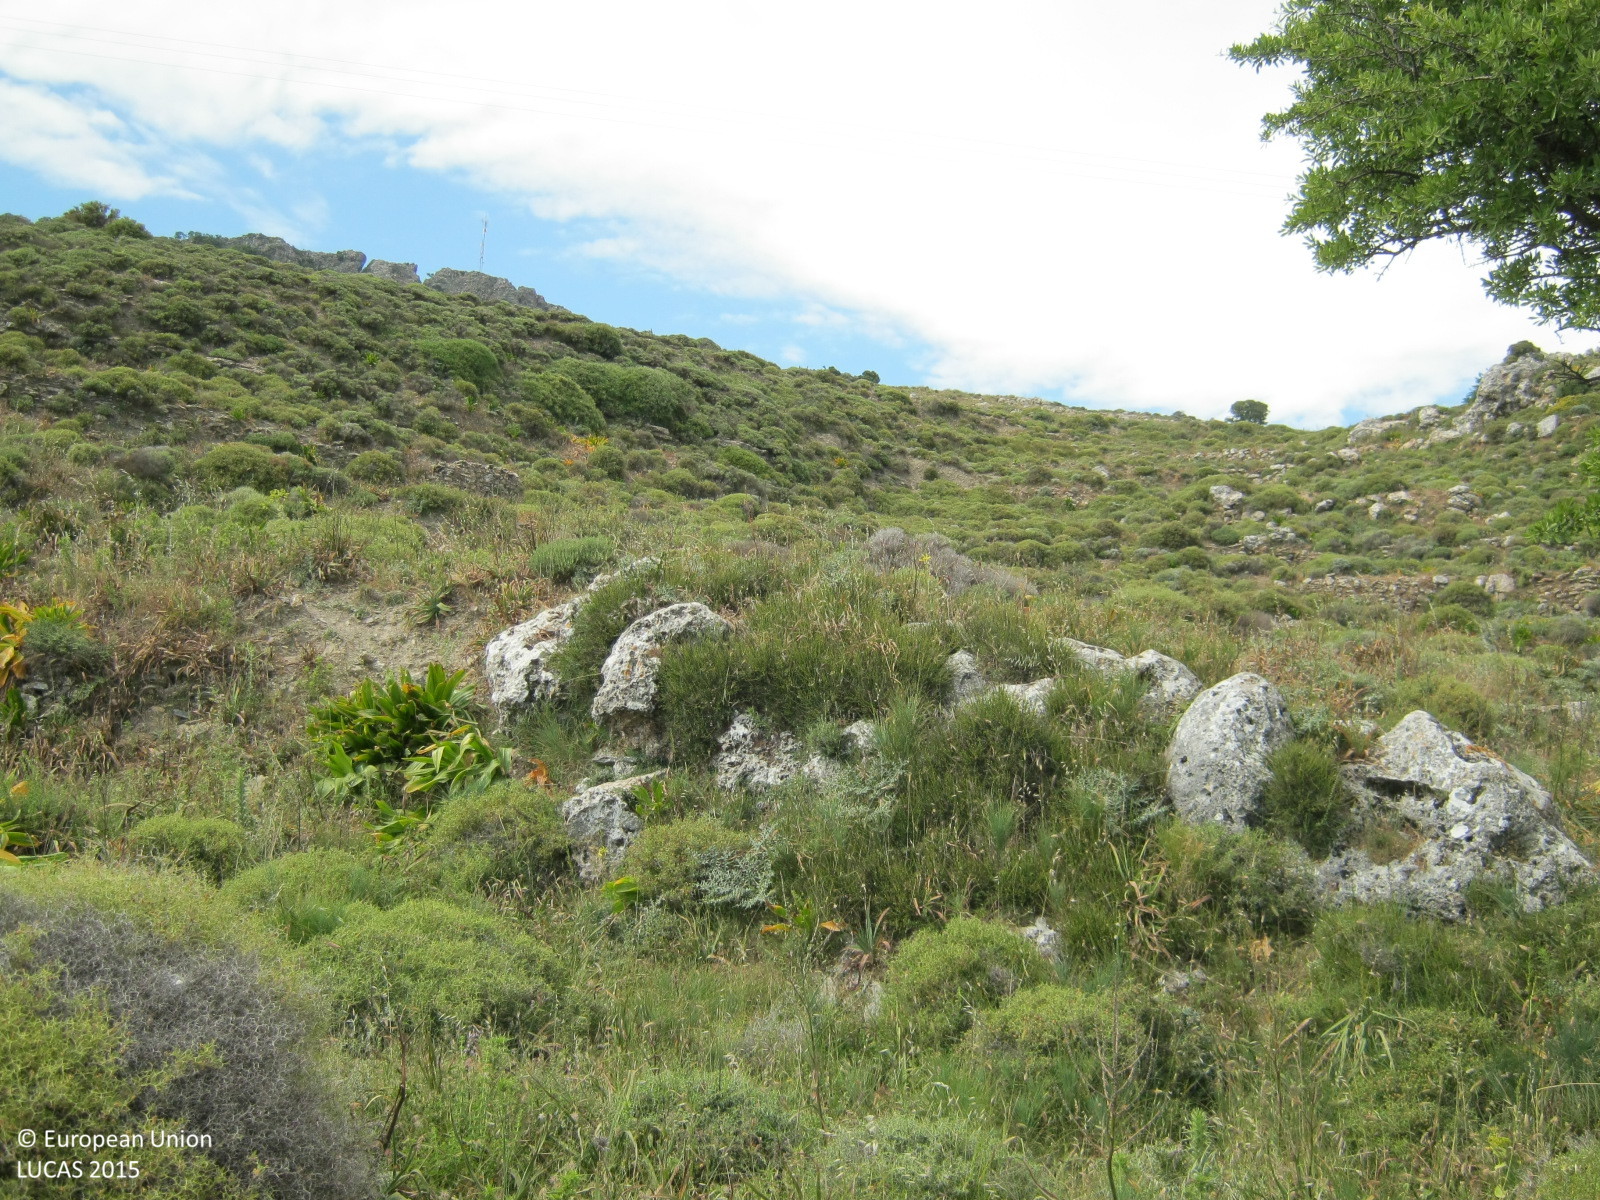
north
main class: Shrubland
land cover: Shrubland with sparse tree cover
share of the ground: > 75 %
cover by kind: shrubs 70 %, unconsolidated bare surface 20 %, broadleaved forest trees 5 %, herbaceous plants 5 %
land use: Agriculture (excluding fallow land and kitchen gardens)
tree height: < 5 m
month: June
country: GR
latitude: 35.2721
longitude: 23.7541
